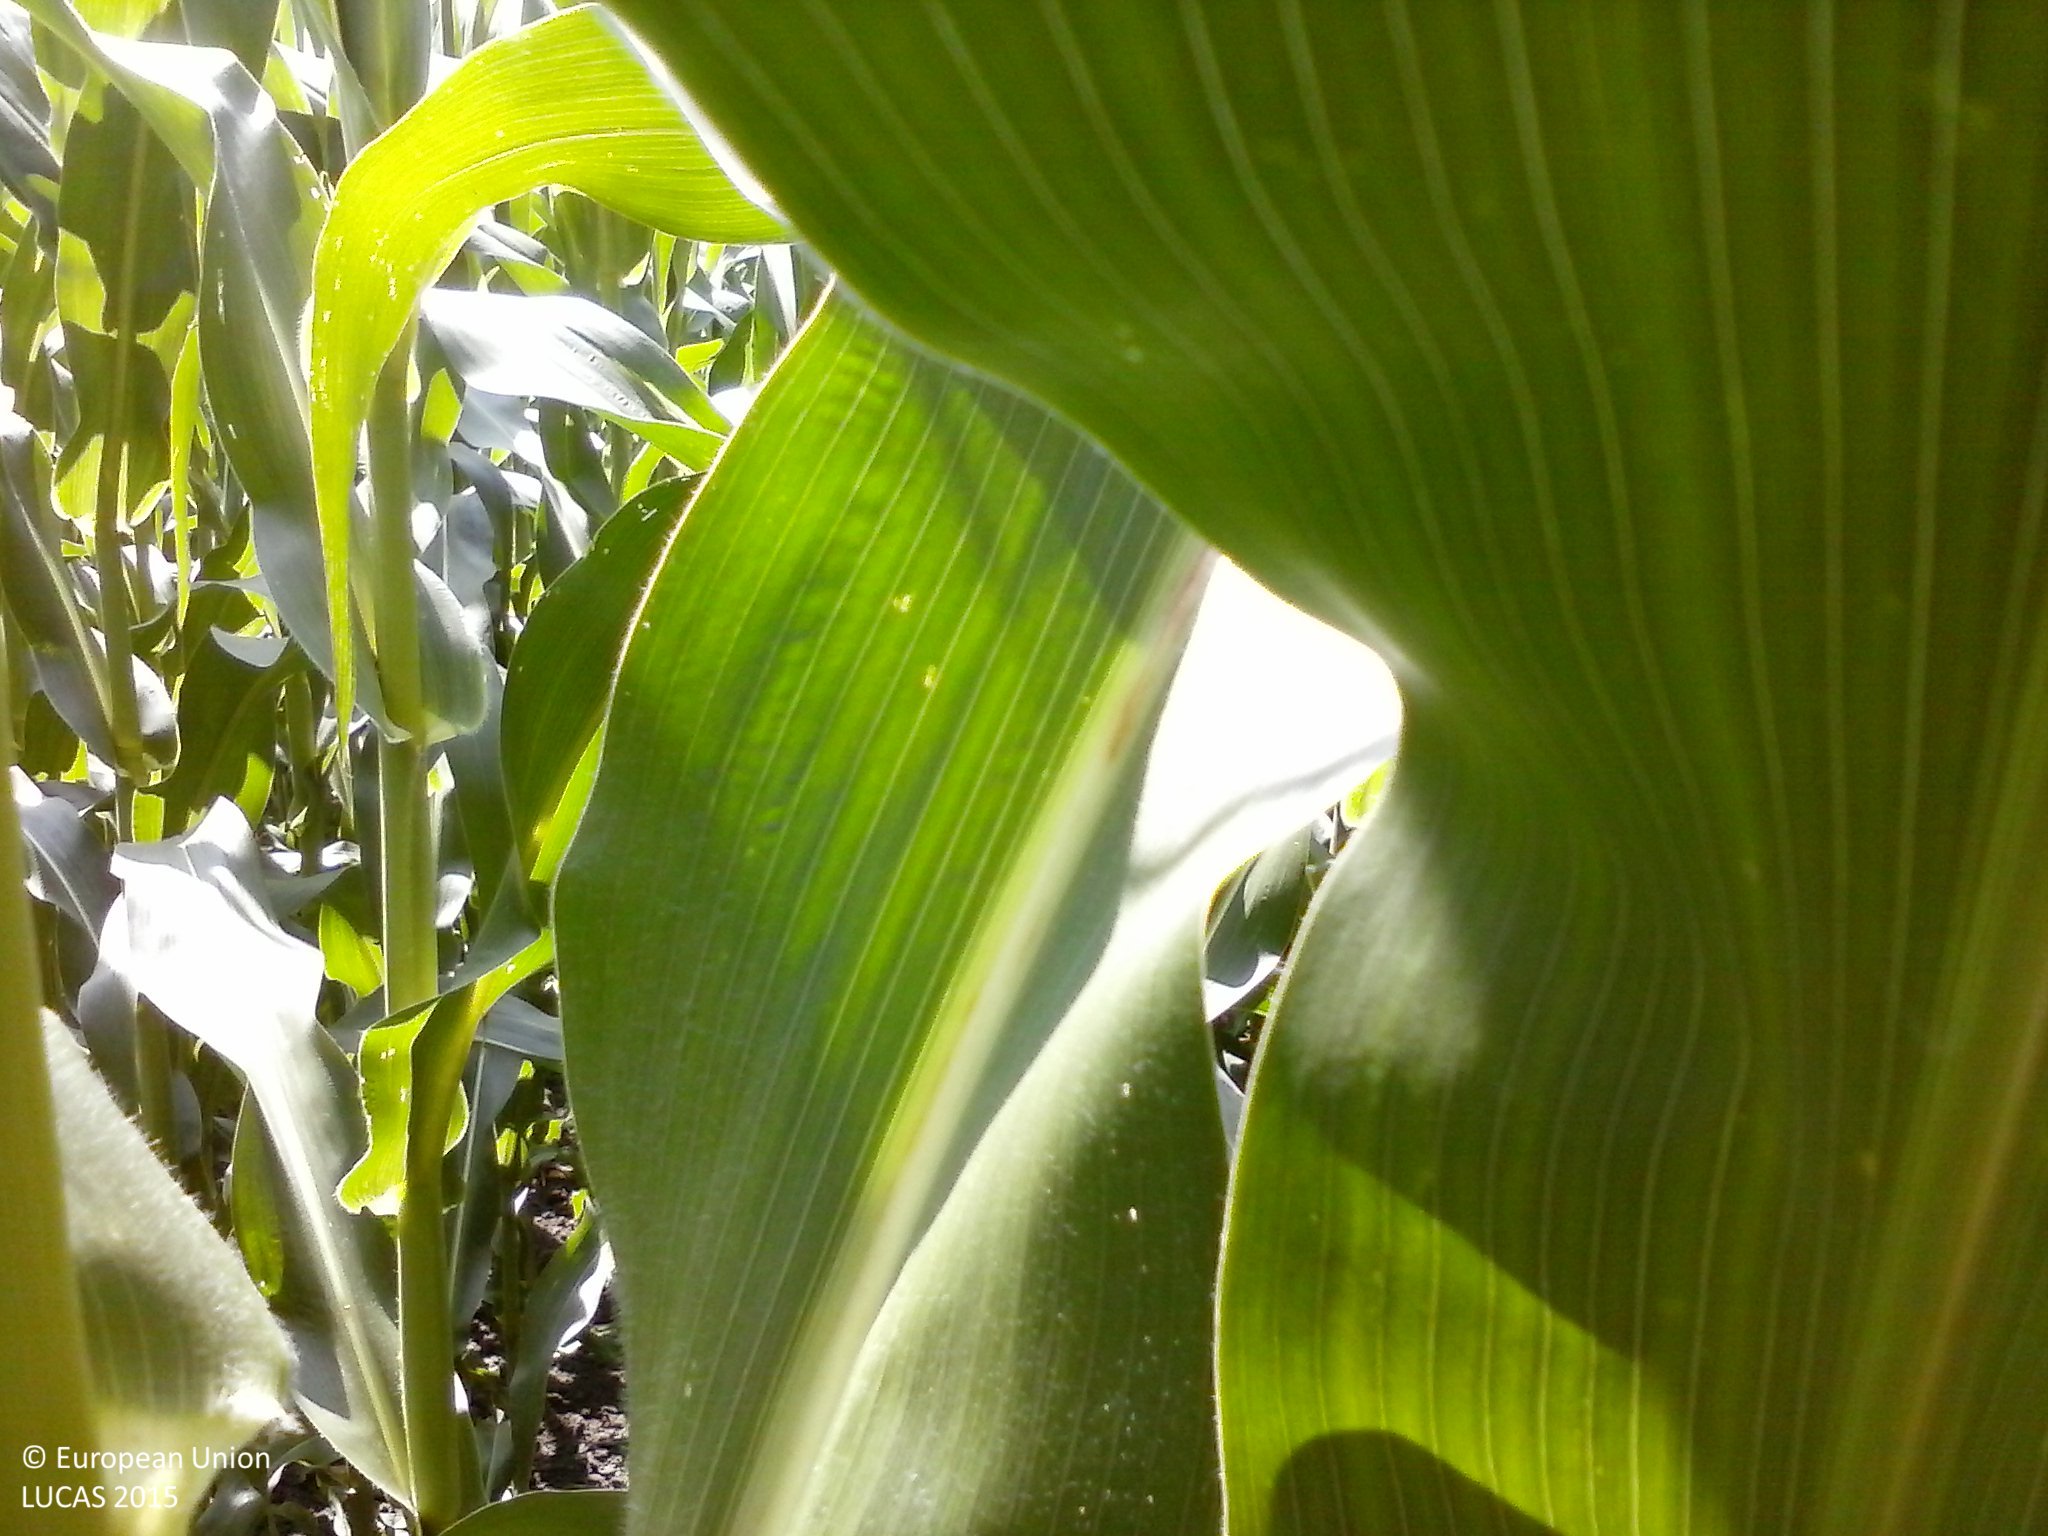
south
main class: Cropland
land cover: Maize
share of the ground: > 75 %
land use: Agriculture (excluding fallow land and kitchen gardens)
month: June
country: HU
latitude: 46.2183
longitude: 19.4925
